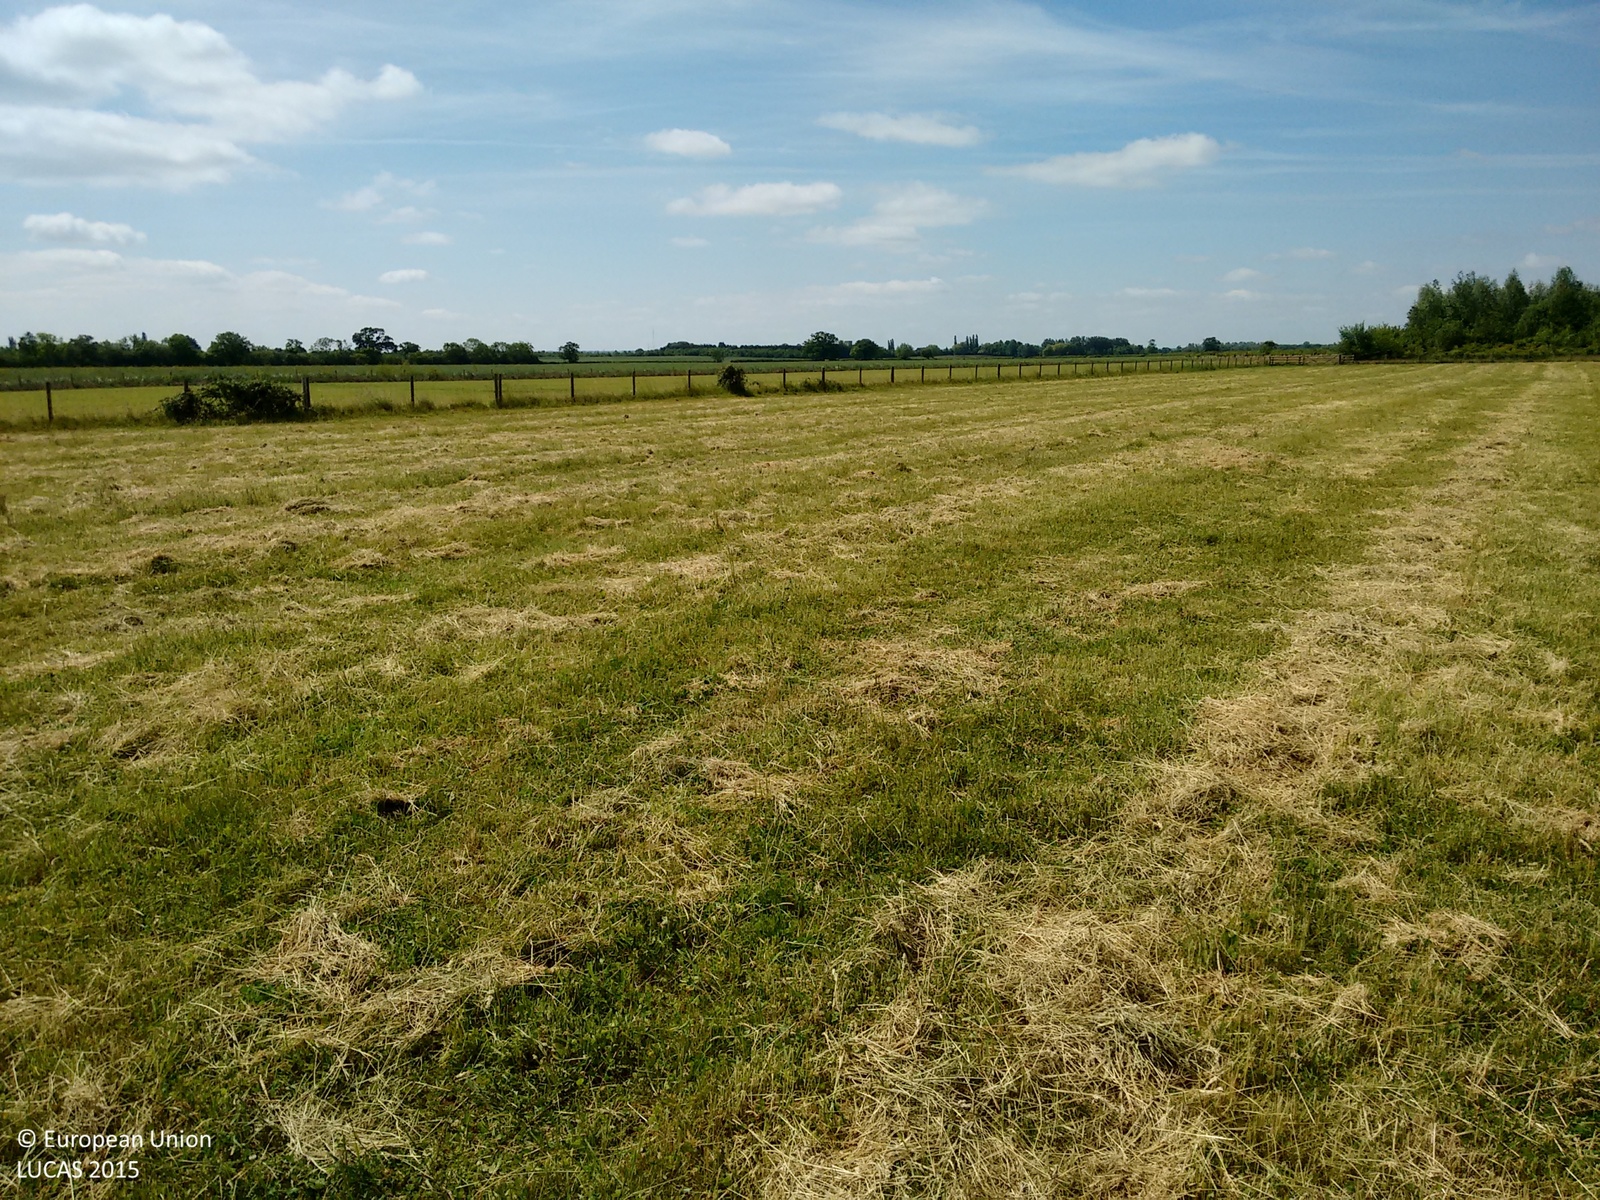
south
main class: Grassland
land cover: Grassland without tree/shrub cover
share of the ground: > 75 %
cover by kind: herbaceous plants 100 %
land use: Agriculture (excluding fallow land and kitchen gardens)
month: June
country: GB
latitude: 51.8679
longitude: -1.1566
